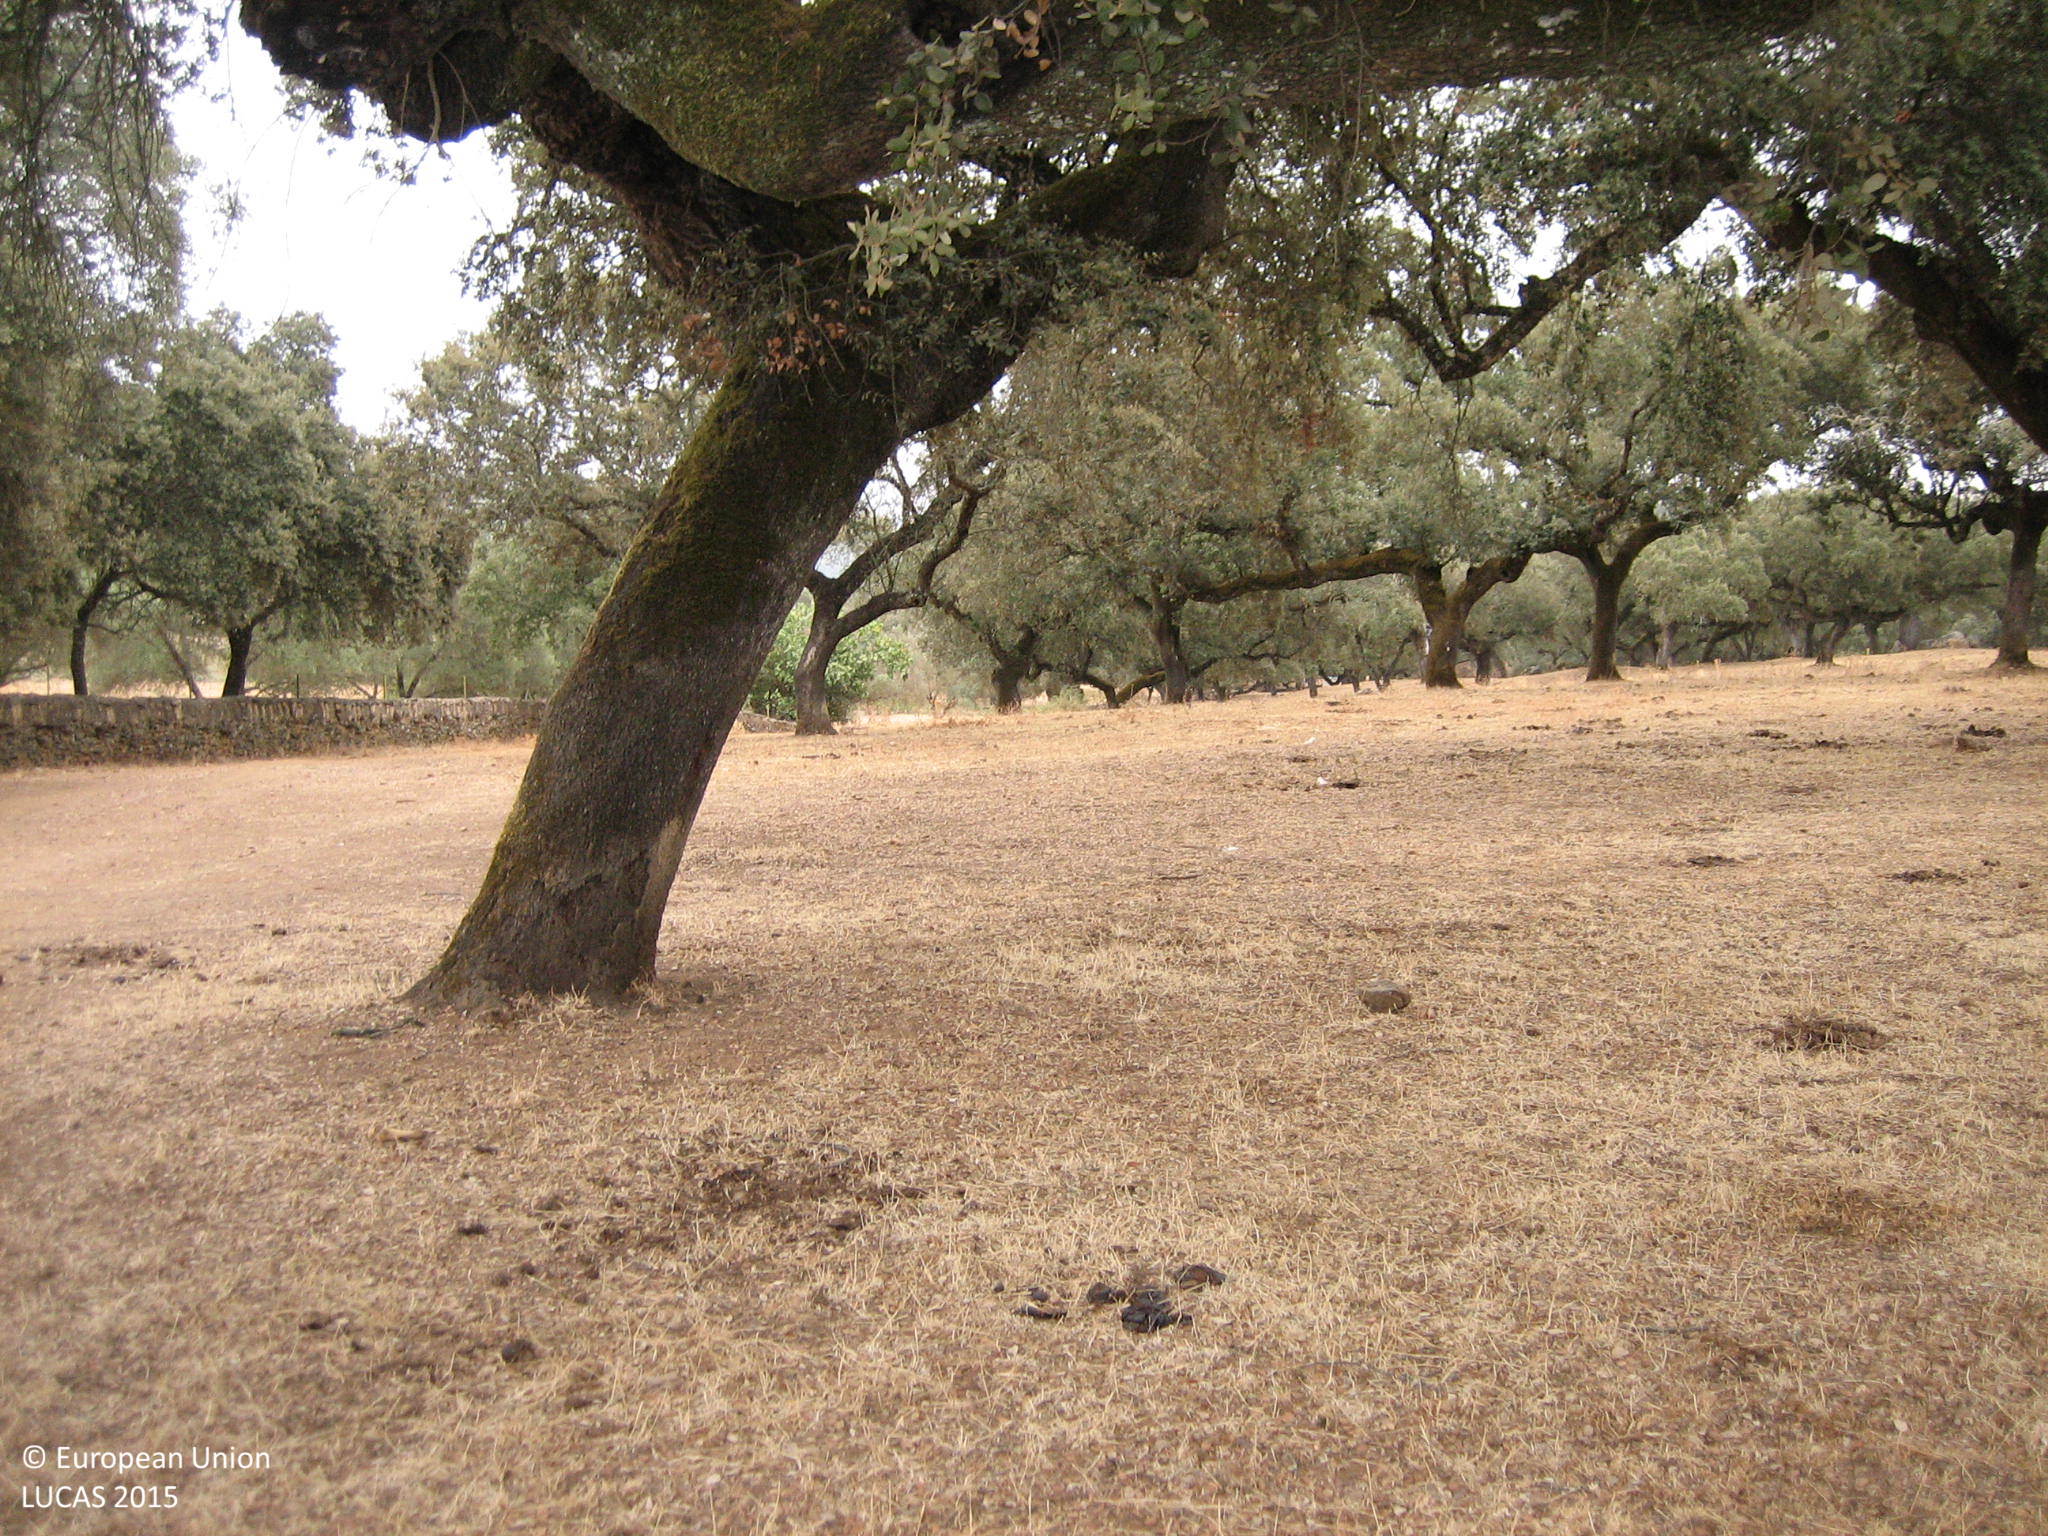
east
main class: Woodland
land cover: Broadleaved woodland
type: broadleaved evergreen forest
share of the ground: > 75 %
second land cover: Grassland without tree/shrub cover
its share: > 75 %
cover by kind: broadleaved forest trees 85 %, herbaceous plants 15 %
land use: Forestry
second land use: Agriculture (excluding fallow land and kitchen gardens)
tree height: > 5 m
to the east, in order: Broadleaved woodland; Grassland without tree/shrub cover; Dry stone walls; Broadleaved woodland
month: September
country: ES
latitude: 38.3170
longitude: -6.8587
